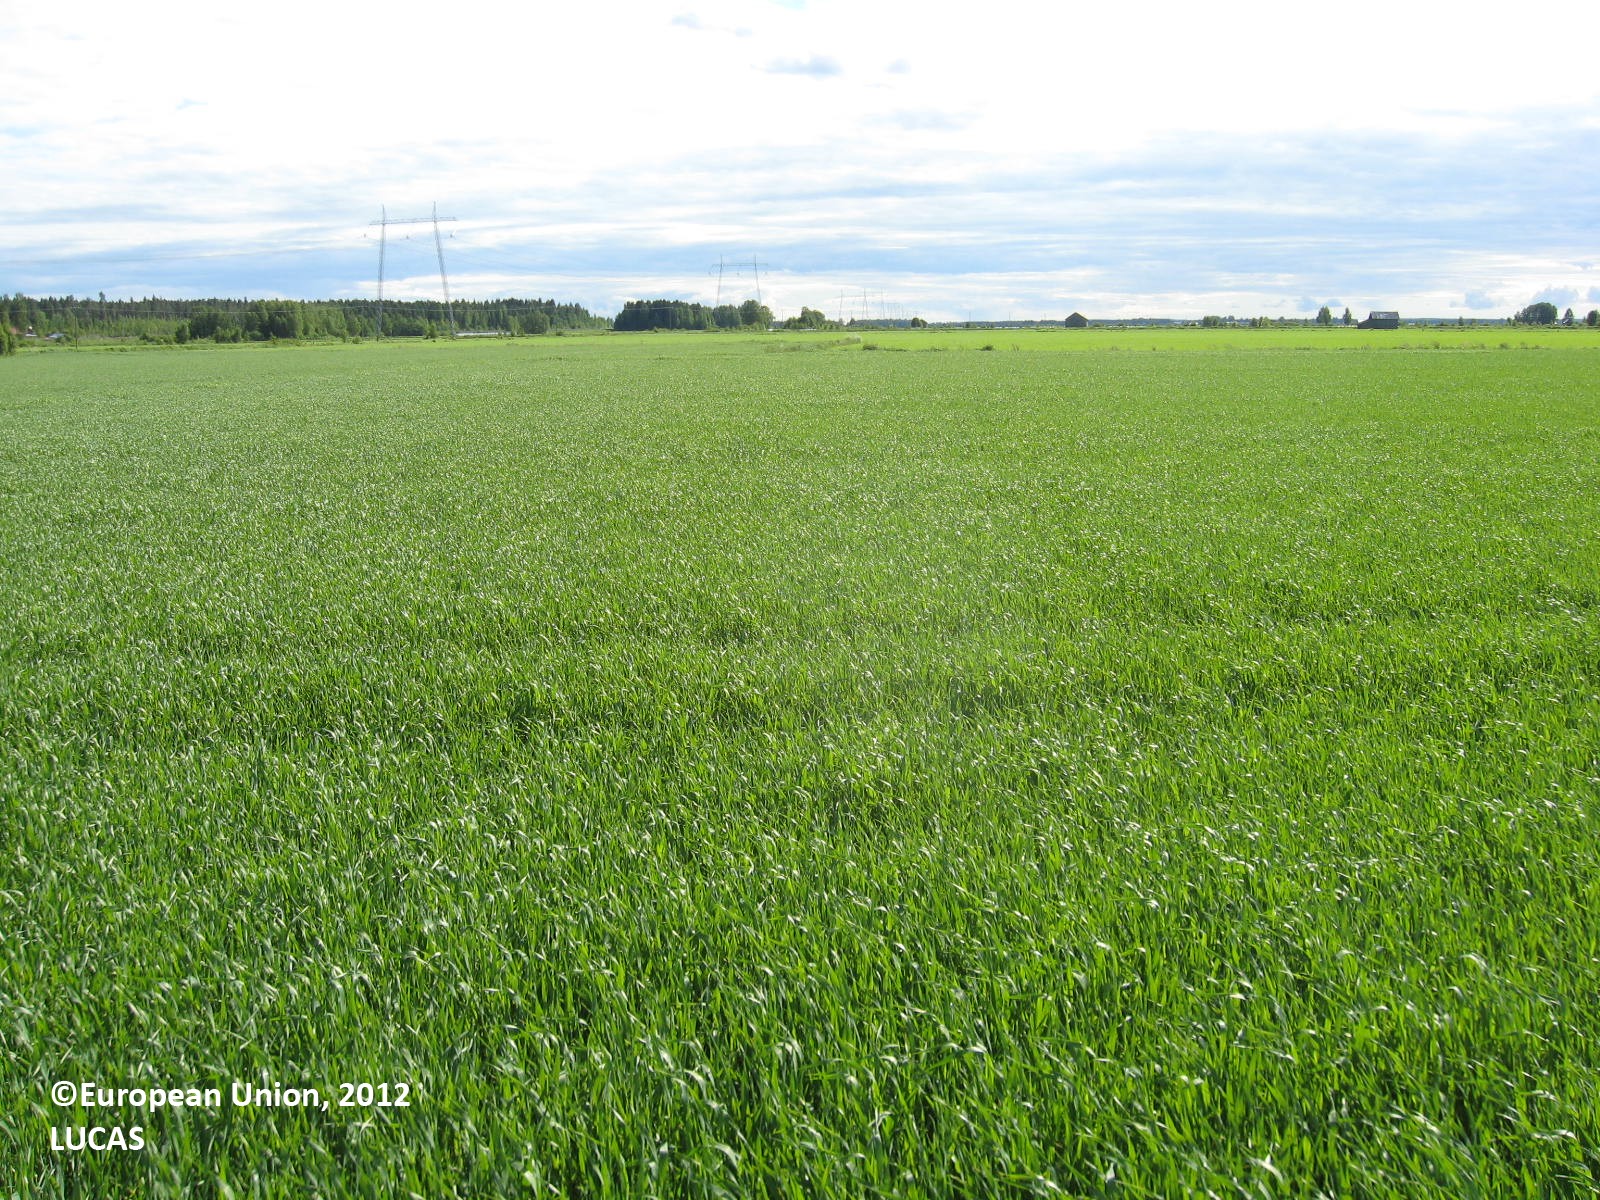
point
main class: Cropland
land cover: Barley
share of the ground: > 75 %
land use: Agriculture (excluding fallow land and kitchen gardens)
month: June
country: FI
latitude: 62.7862
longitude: 22.6985
